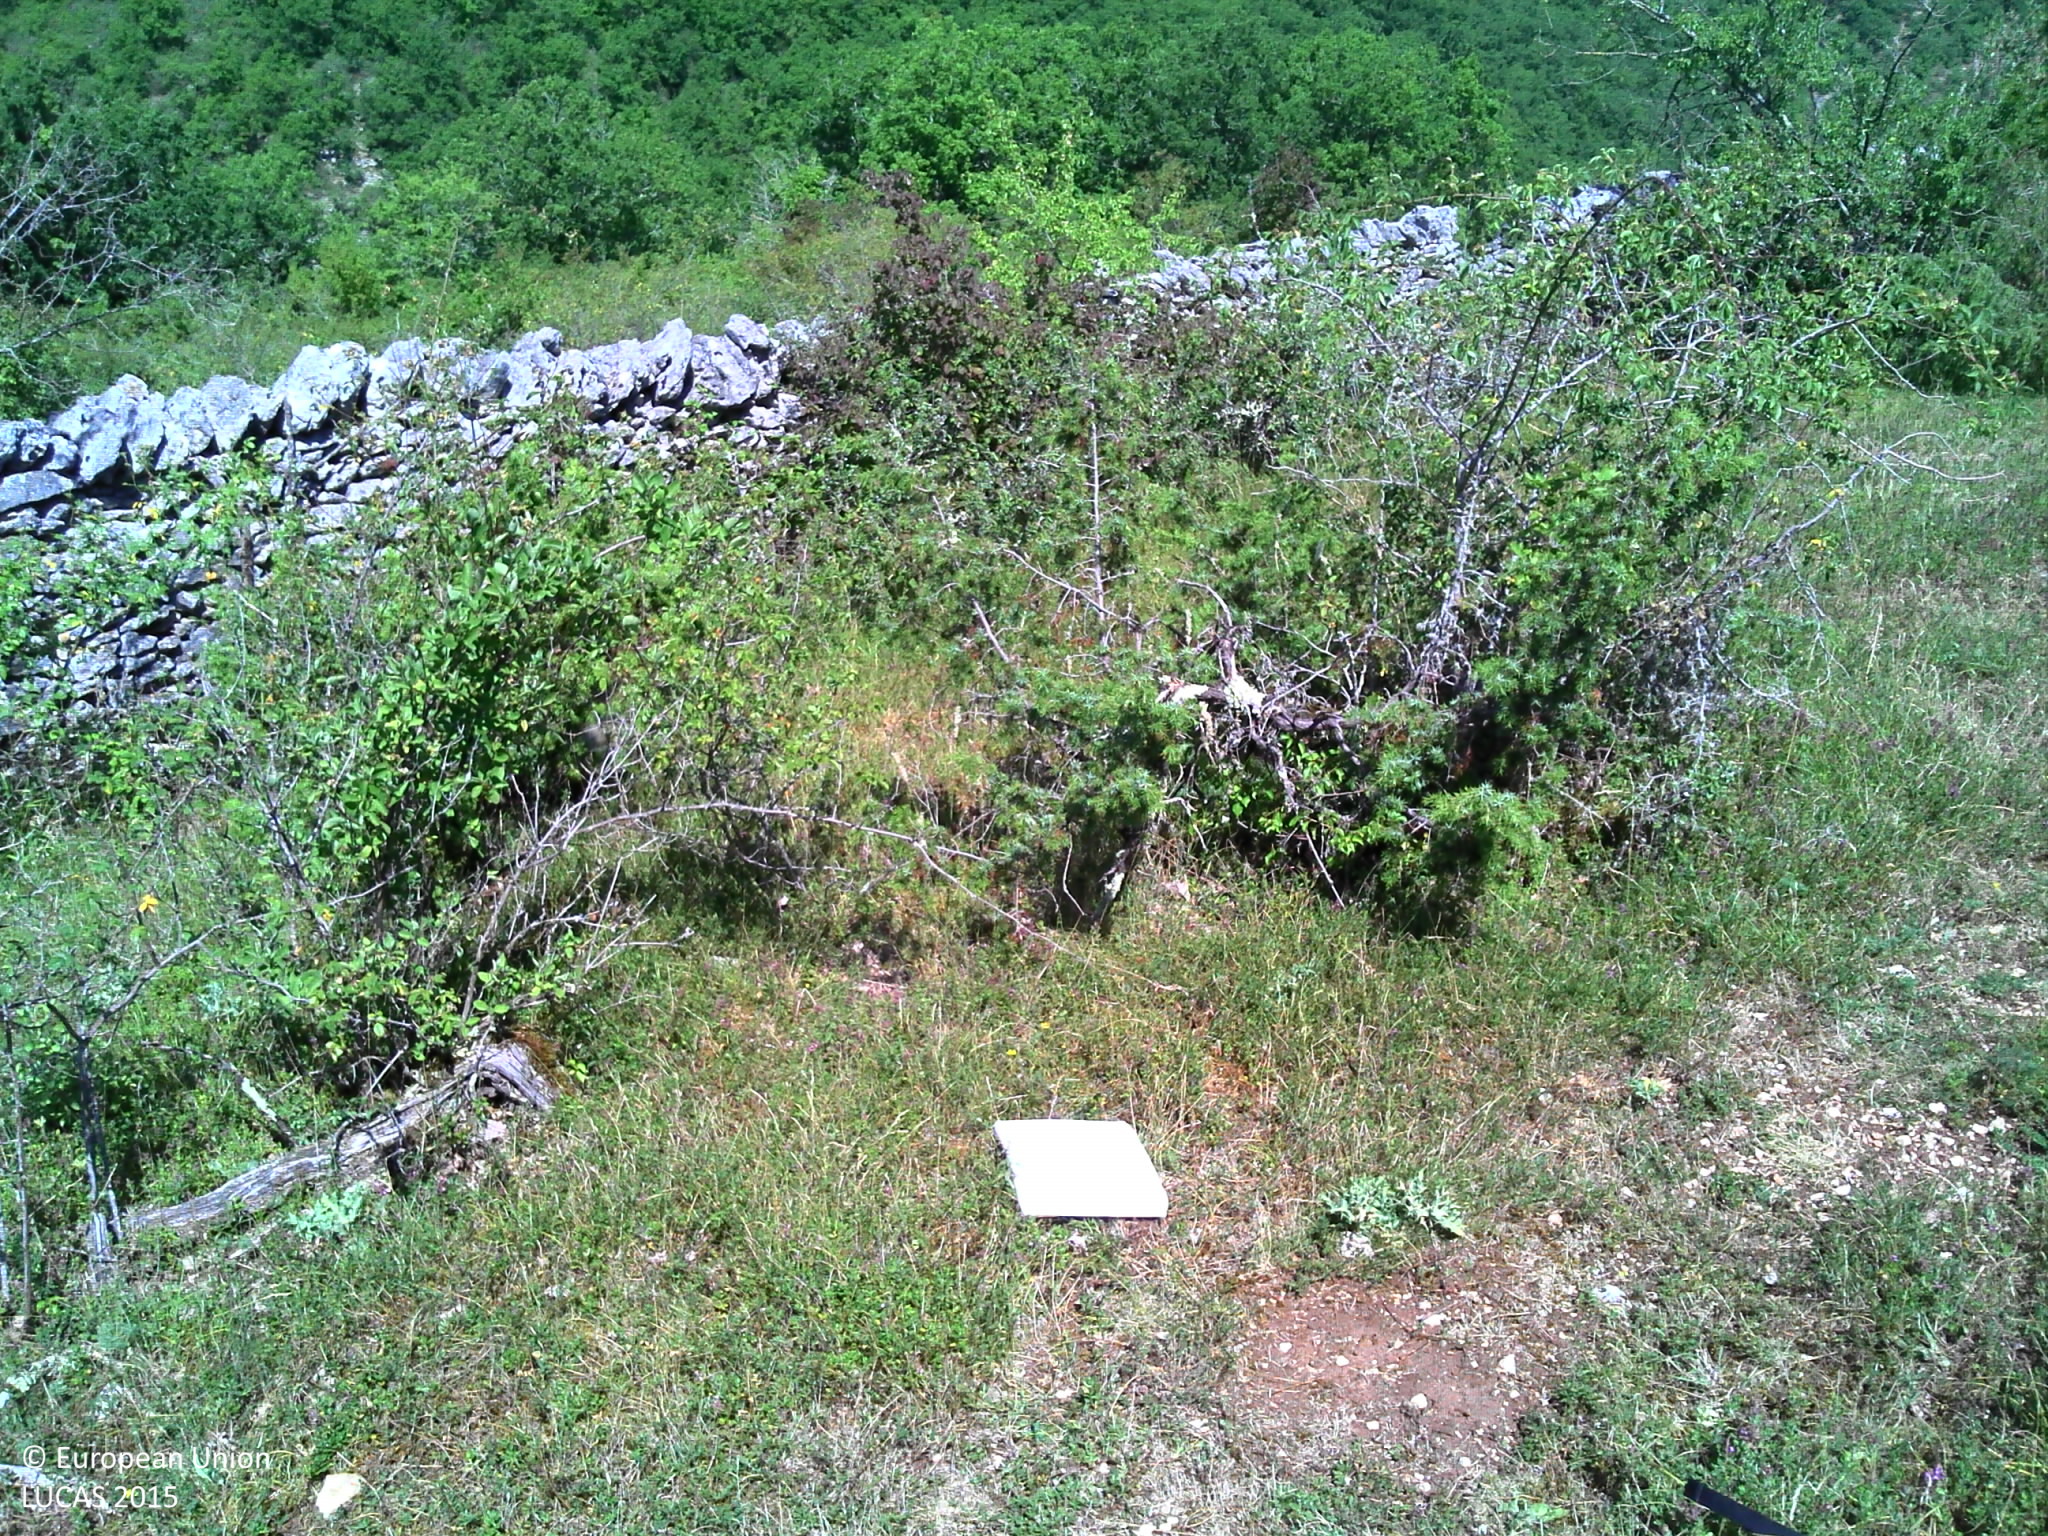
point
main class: Grassland
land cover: Grassland with sparse tree/shrub cover
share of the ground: > 75 %
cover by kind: herbaceous plants 95 %, broadleaved forest trees 5 %
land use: Agriculture (excluding fallow land and kitchen gardens)
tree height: < 5 m
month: June
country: FR
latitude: 44.8439
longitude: 1.6092
